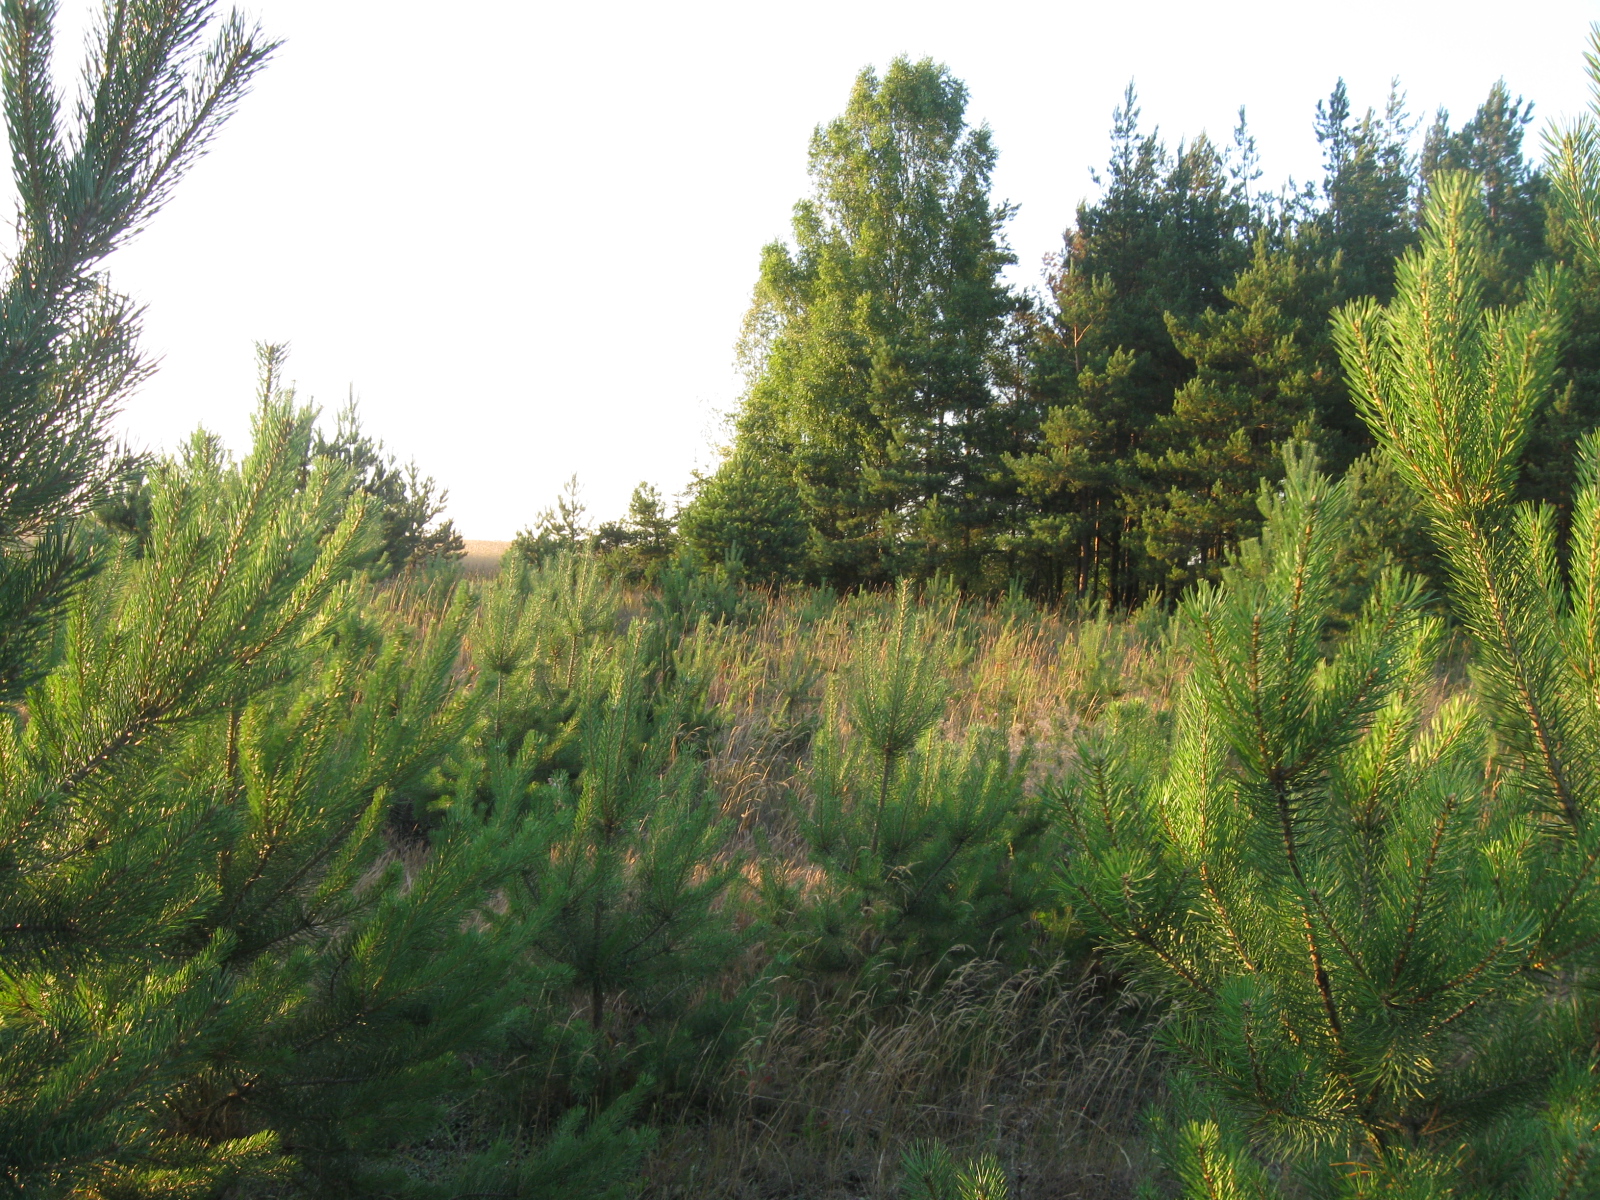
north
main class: Woodland
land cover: Pine dominated coniferous woodland
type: hemiboreal forest and nemoral coniferous forest and mixed broadleaved-coniferous forest
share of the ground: 25 - 50 %
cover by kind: herbaceous plants 55 %, coniferous forest trees 45 %
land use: Forestry
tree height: < 5 m
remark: Nursery
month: July
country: LT
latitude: 54.0956
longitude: 23.7110
